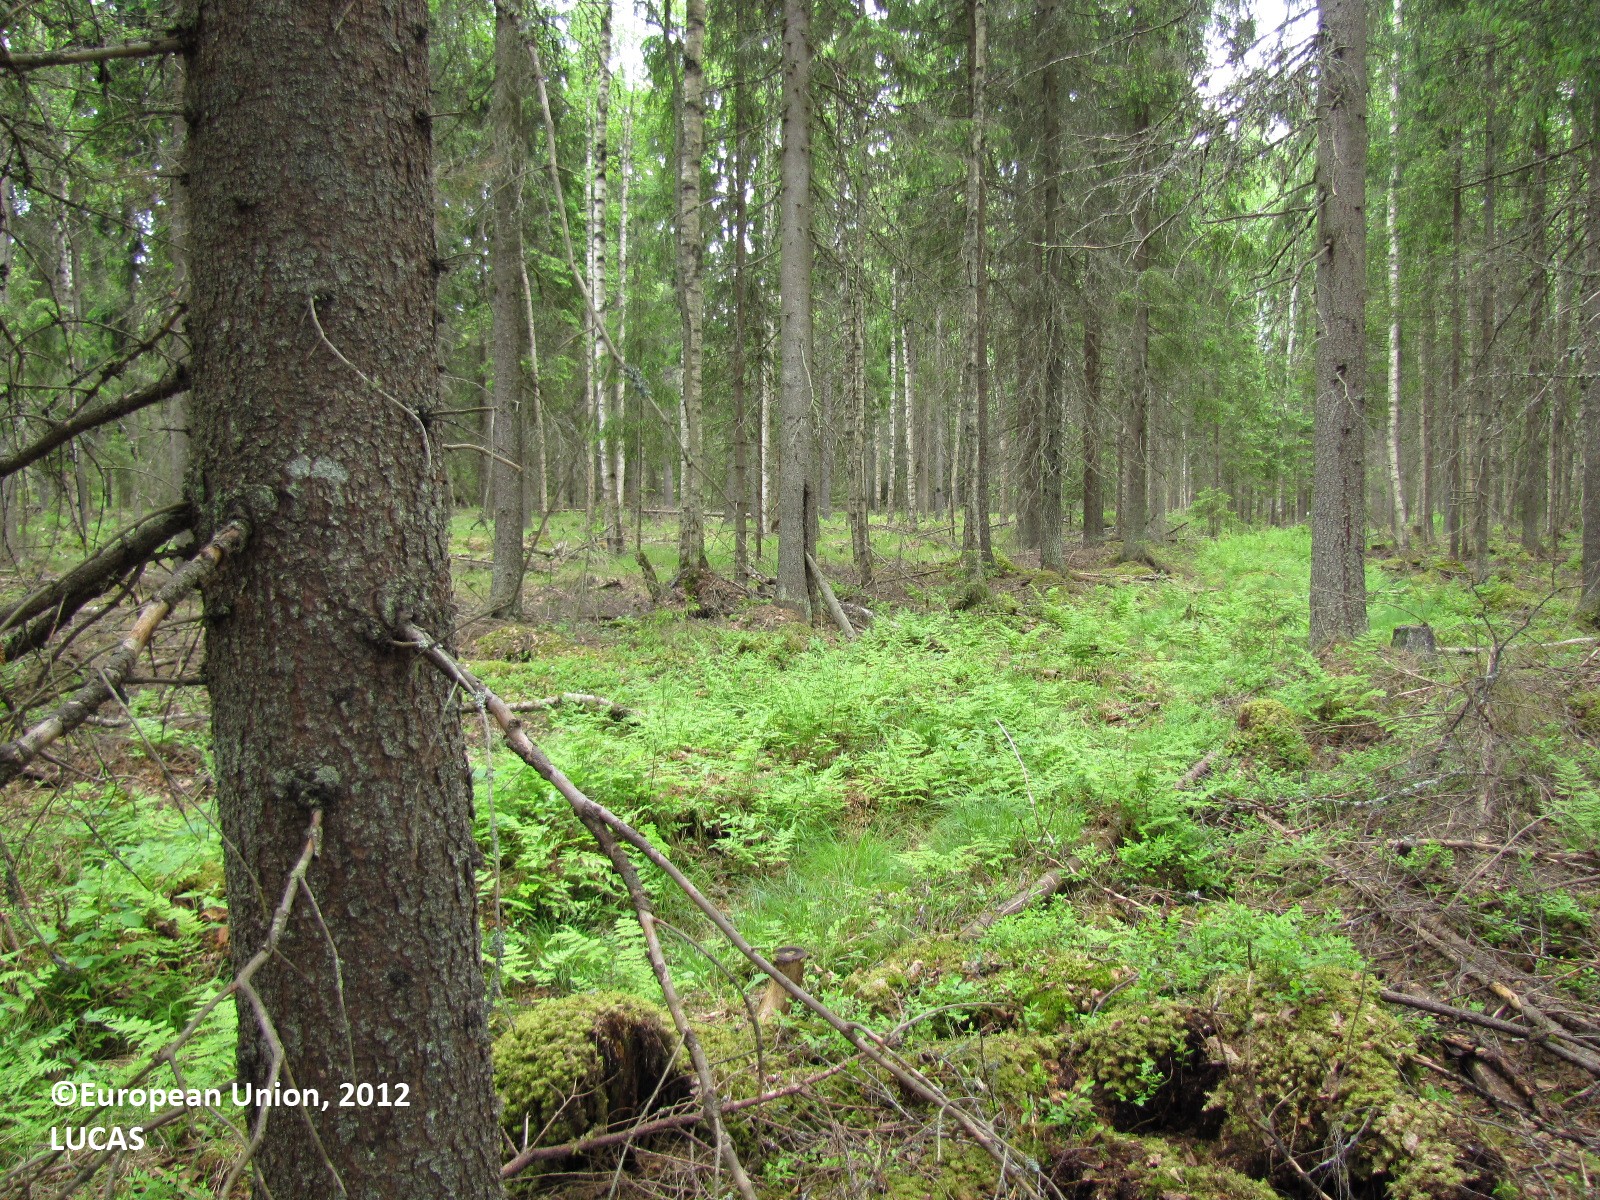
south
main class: Woodland
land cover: Spruce dominated mixed woodland
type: hemiboreal forest and nemoral coniferous forest and mixed broadleaved-coniferous forest
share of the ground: 50 - 75 %
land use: Forestry
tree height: > 5 m
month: June
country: FI
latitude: 61.2366
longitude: 23.4377
